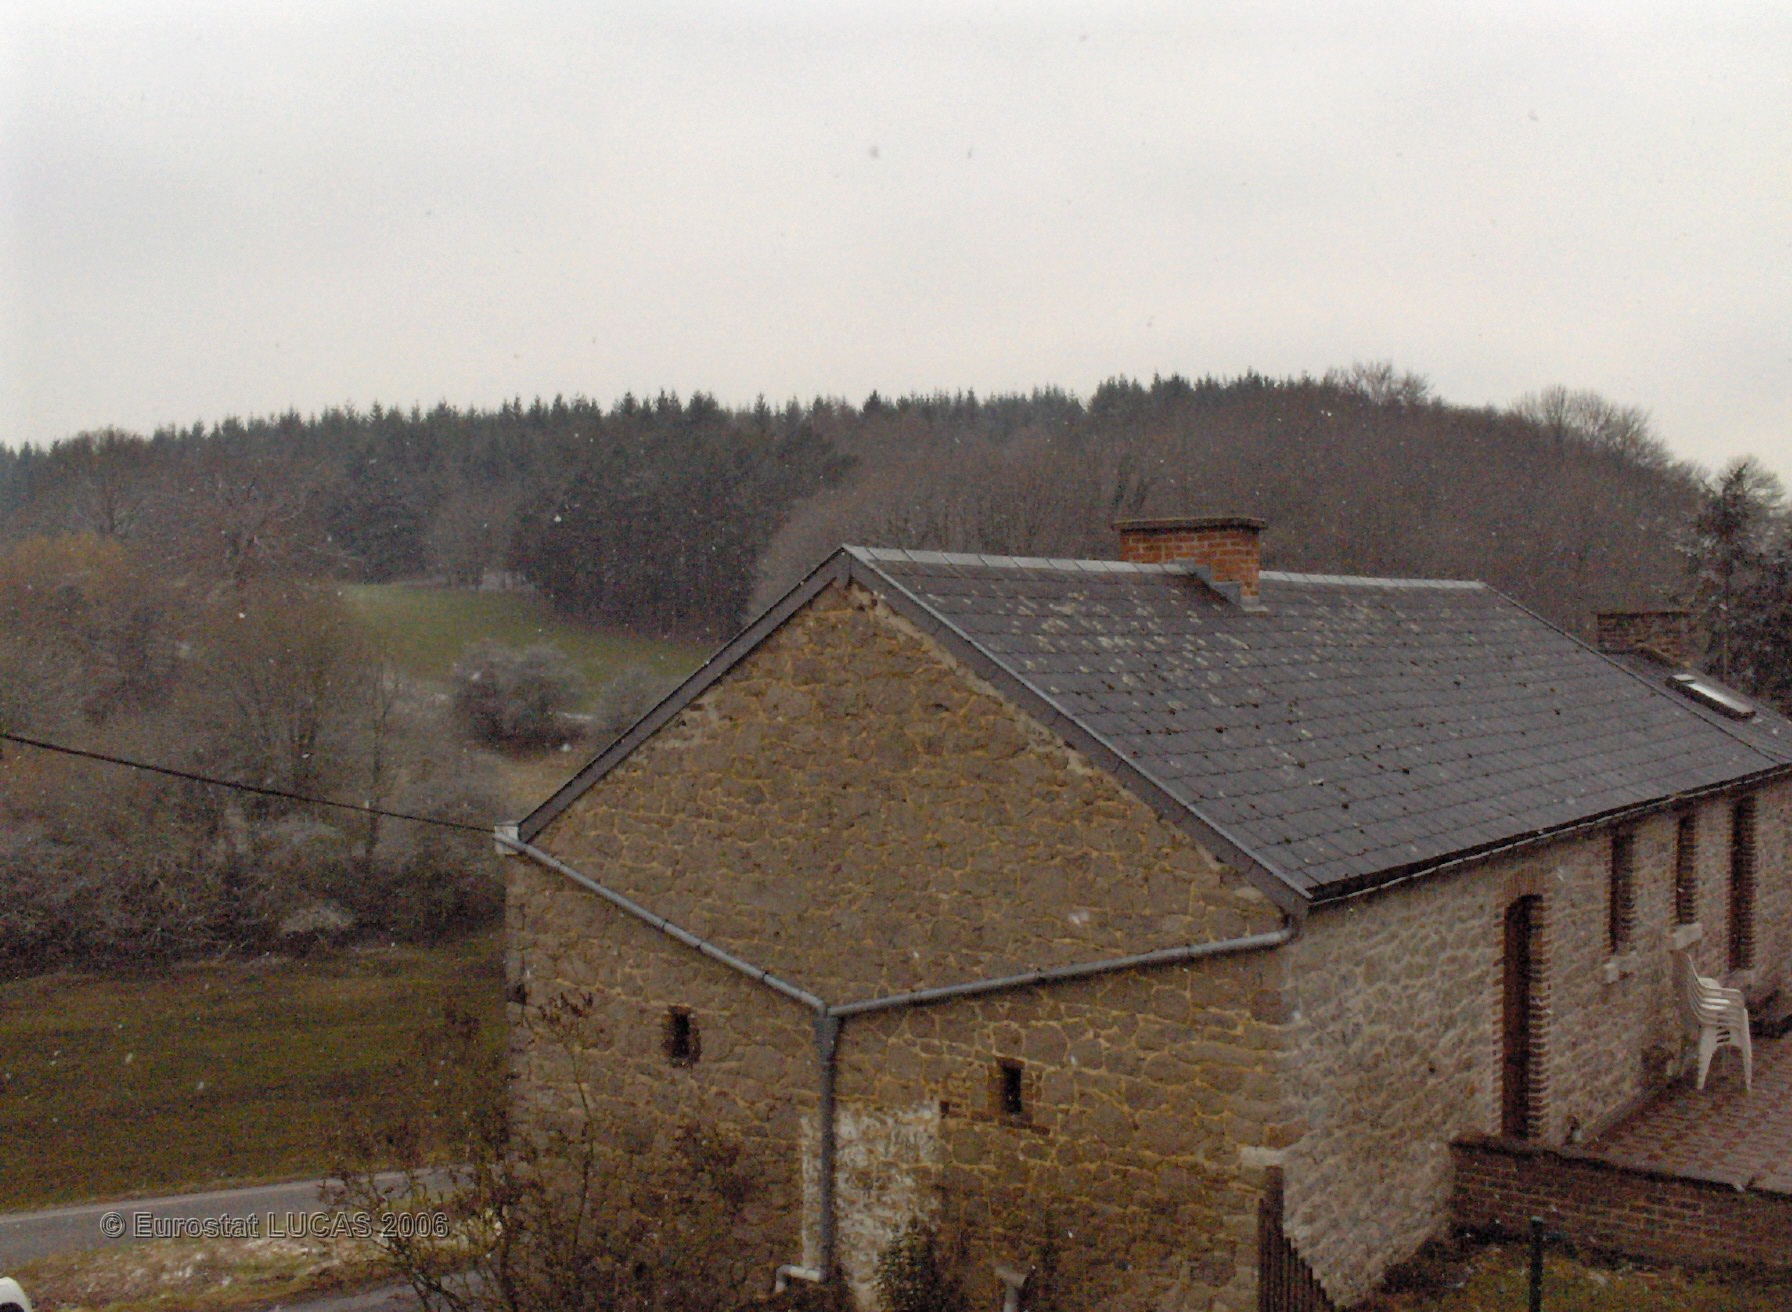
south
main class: Grassland
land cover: Grassland without tree/shrub cover
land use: Agriculture (excluding fallow land and kitchen gardens)
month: March
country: BE
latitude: 50.5162
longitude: 5.2167
